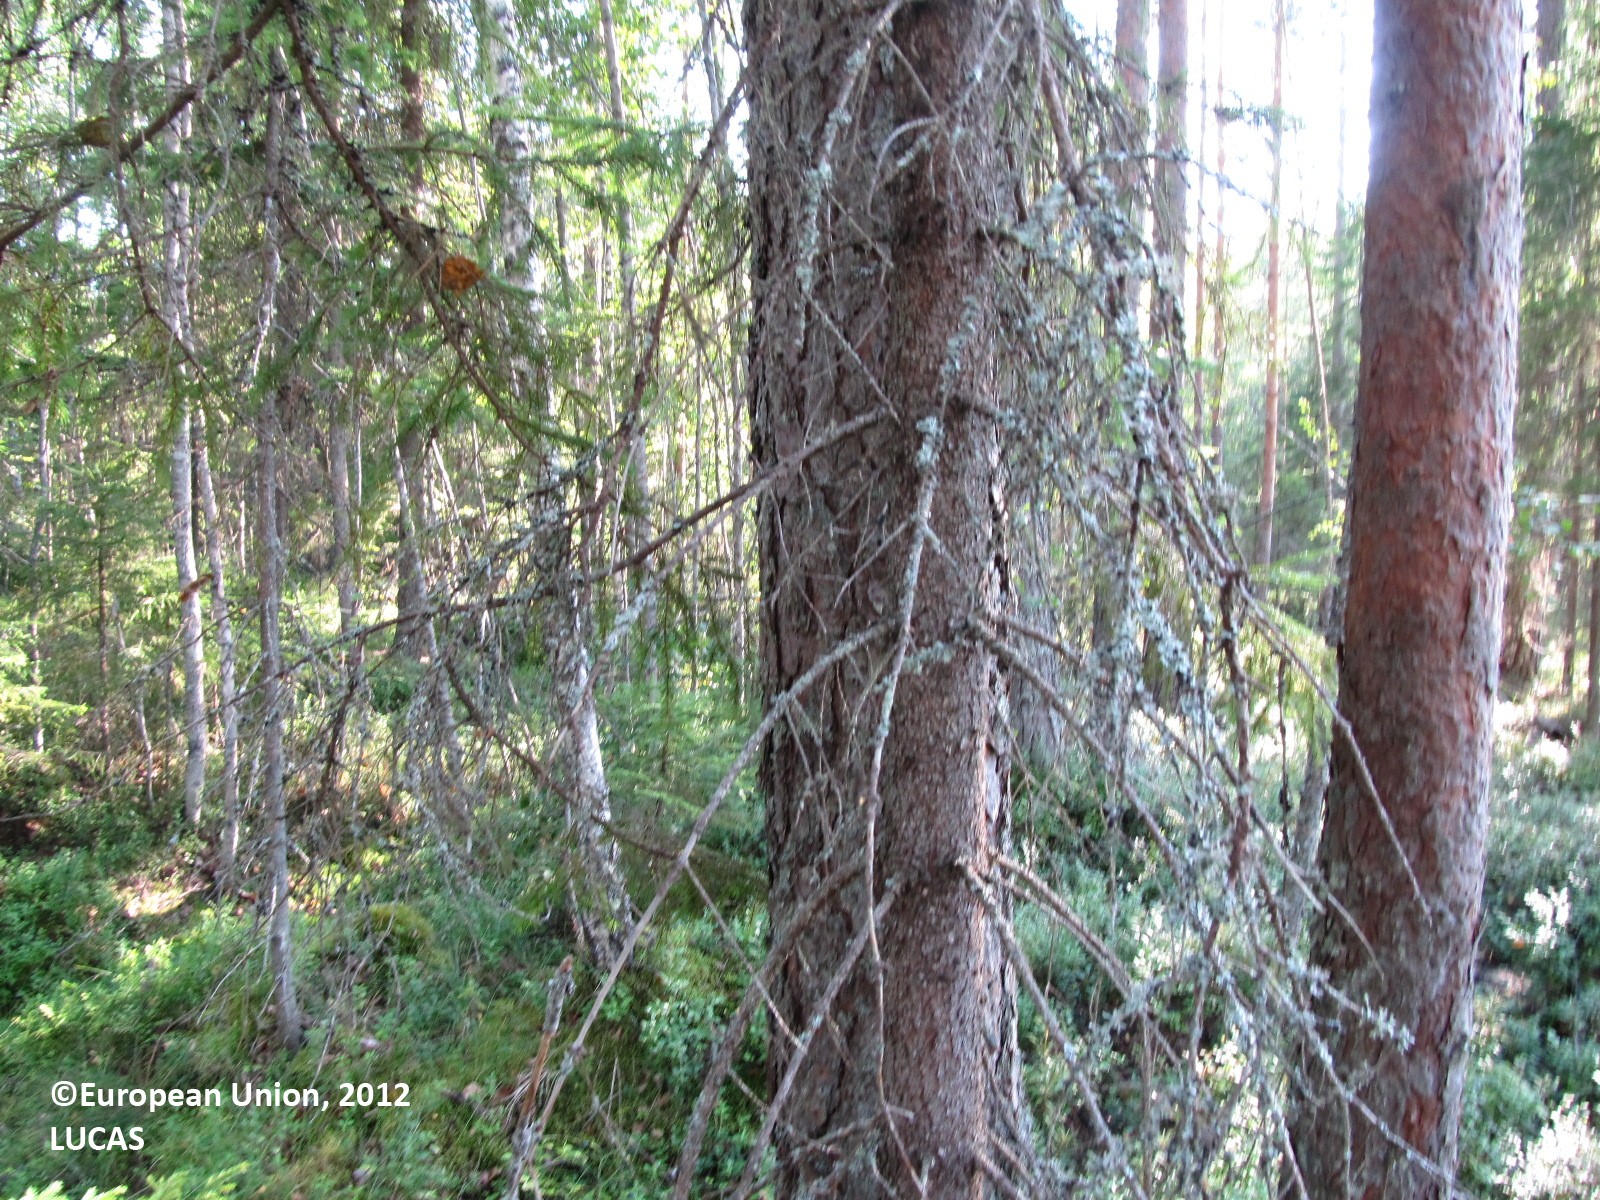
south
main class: Woodland
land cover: Pine dominated mixed woodland
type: boreal forest
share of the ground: 25 - 50 %
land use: Forestry
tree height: > 5 m
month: August
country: FI
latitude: 62.1410
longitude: 27.5719
